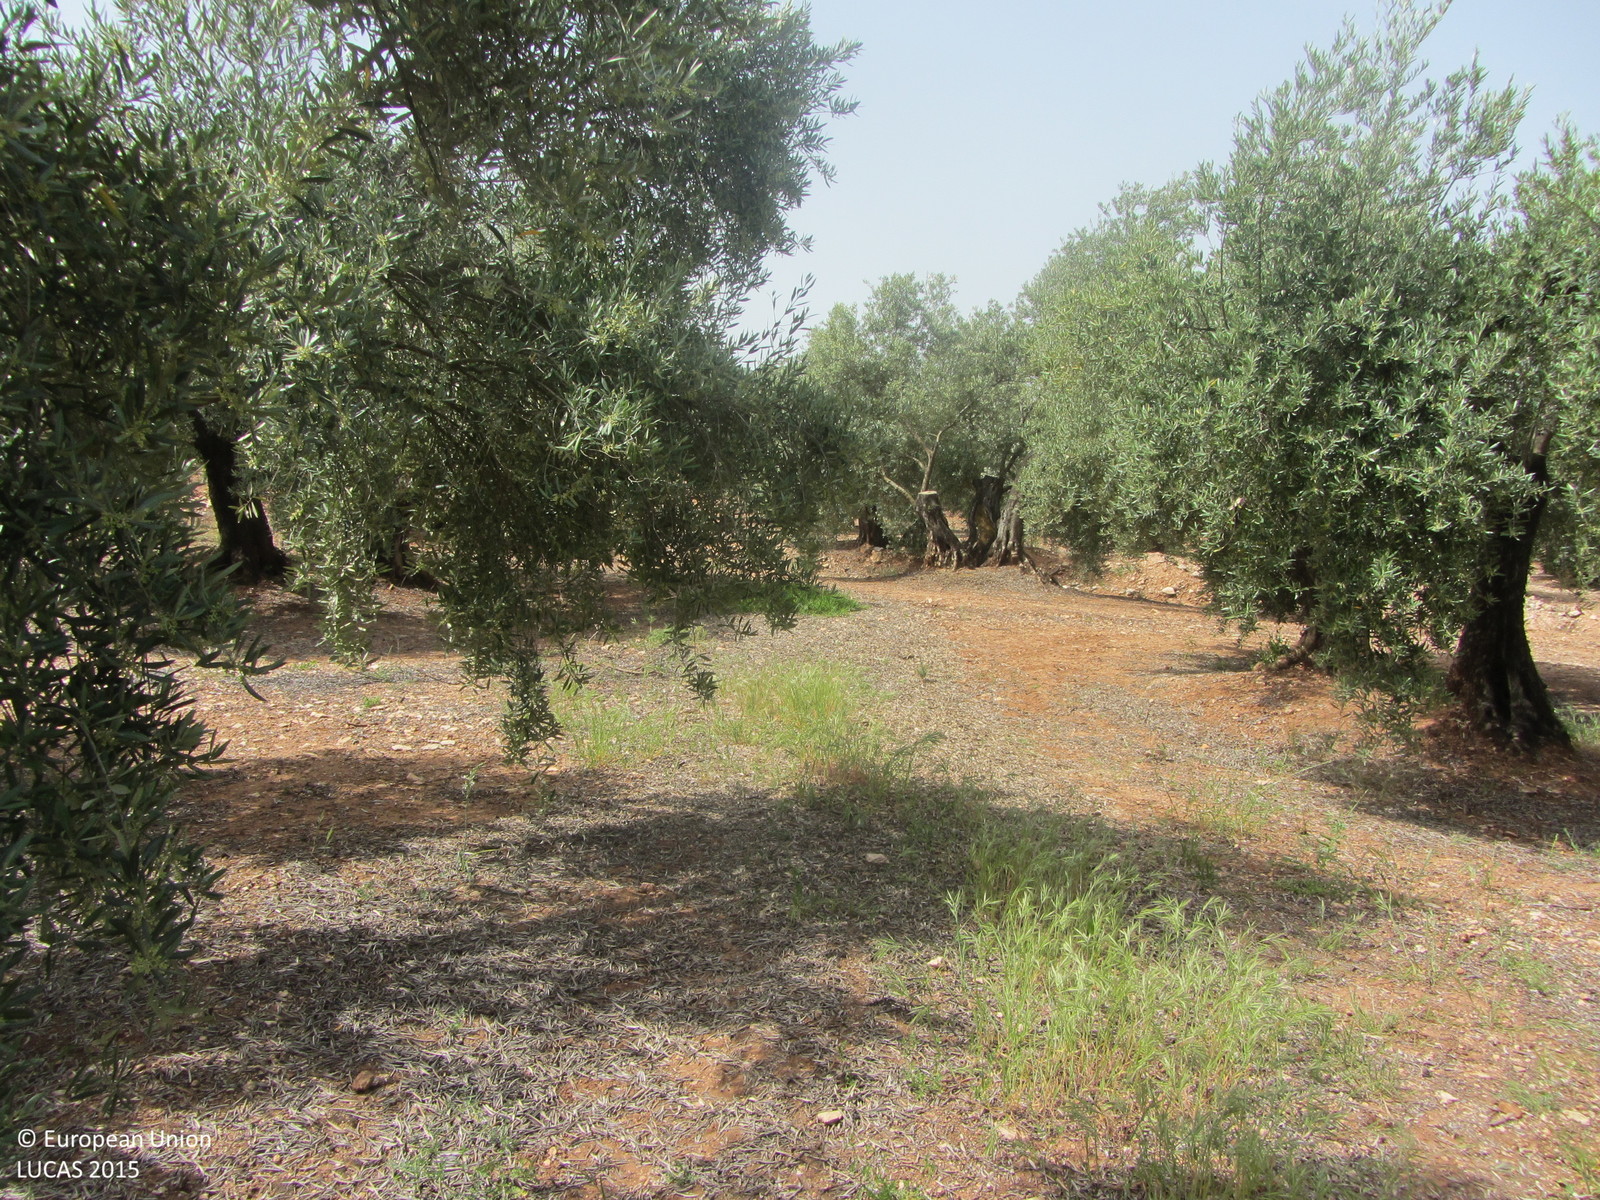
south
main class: Cropland
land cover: Olive groves
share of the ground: 50 - 75 %
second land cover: Spontaneously vegetated surfaces
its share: 10 - 25 %
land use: Agriculture (excluding fallow land and kitchen gardens)
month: May
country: ES
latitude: 38.2937
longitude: -2.9085
